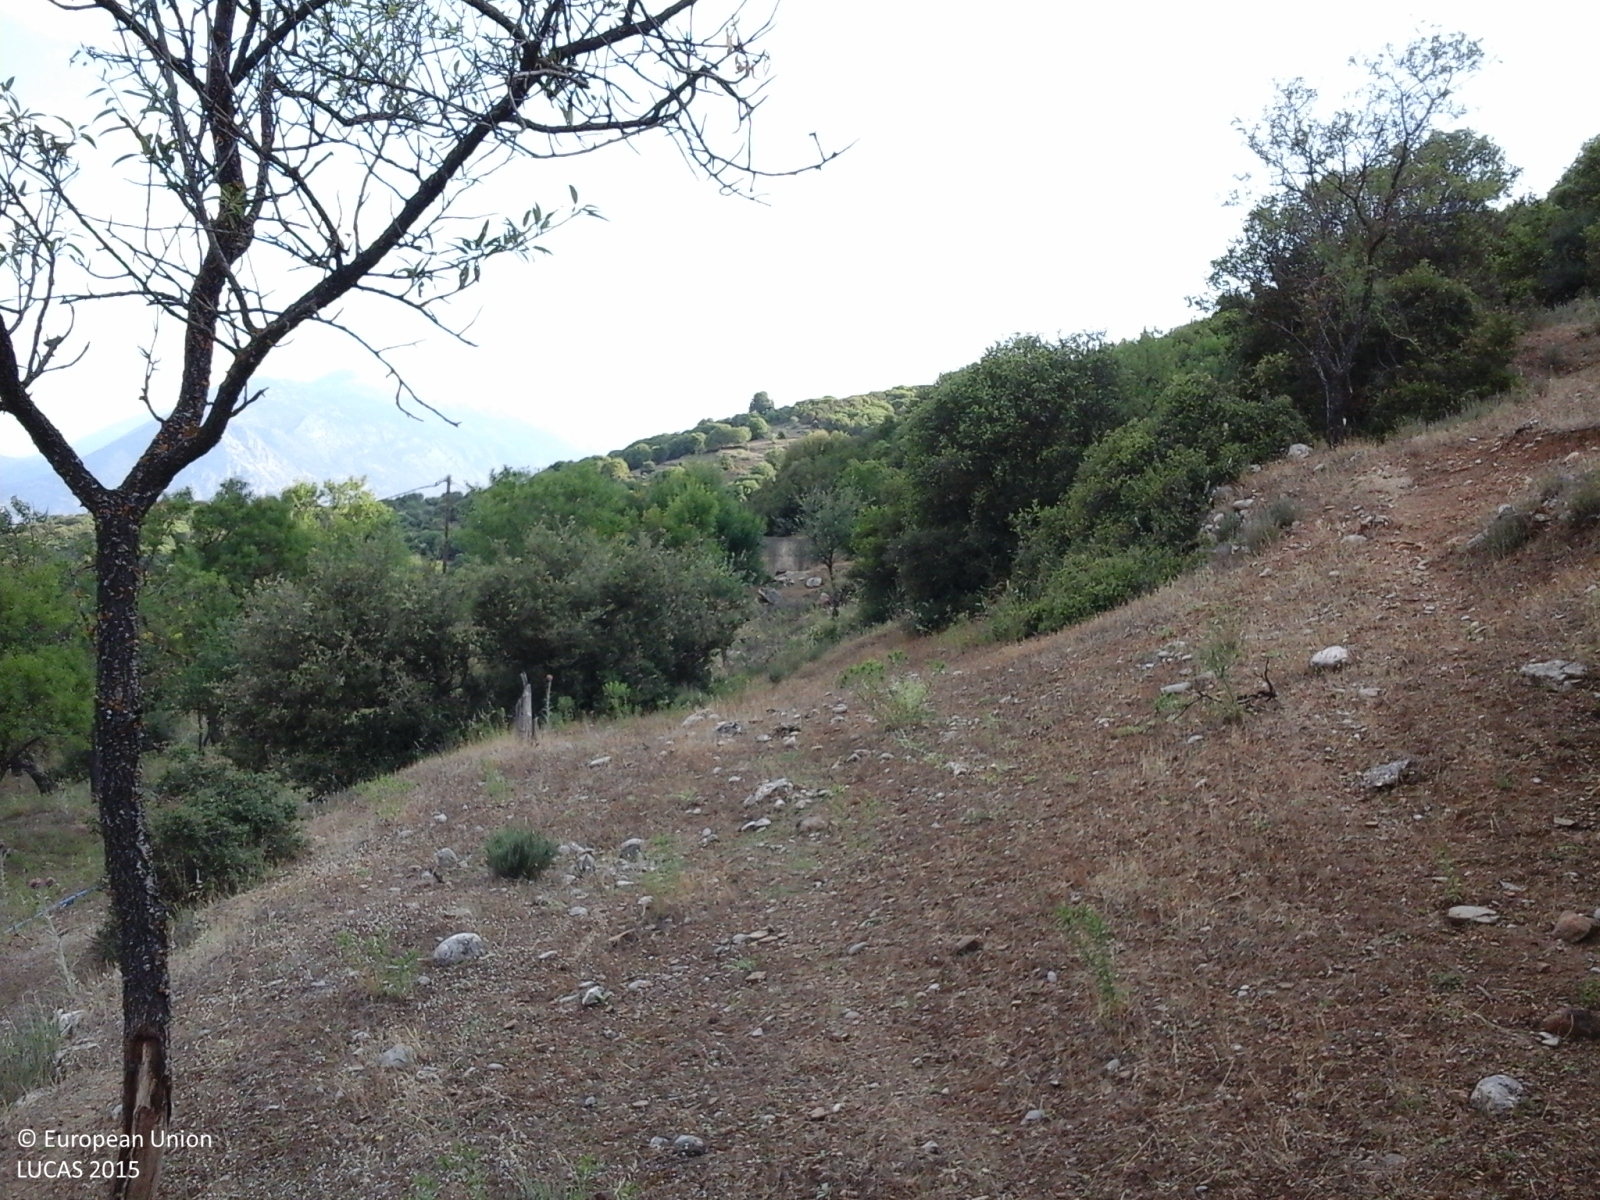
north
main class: Grassland
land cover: Grassland with sparse tree/shrub cover
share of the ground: > 75 %
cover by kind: herbaceous plants 60 %, unconsolidated bare surface 25 %, shrubs 10 %, broadleaved forest trees 5 %
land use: Agriculture (excluding fallow land and kitchen gardens)
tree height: < 5 m
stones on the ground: 10 - 25 %
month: July
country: GR
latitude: 38.4960
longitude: 22.2077
